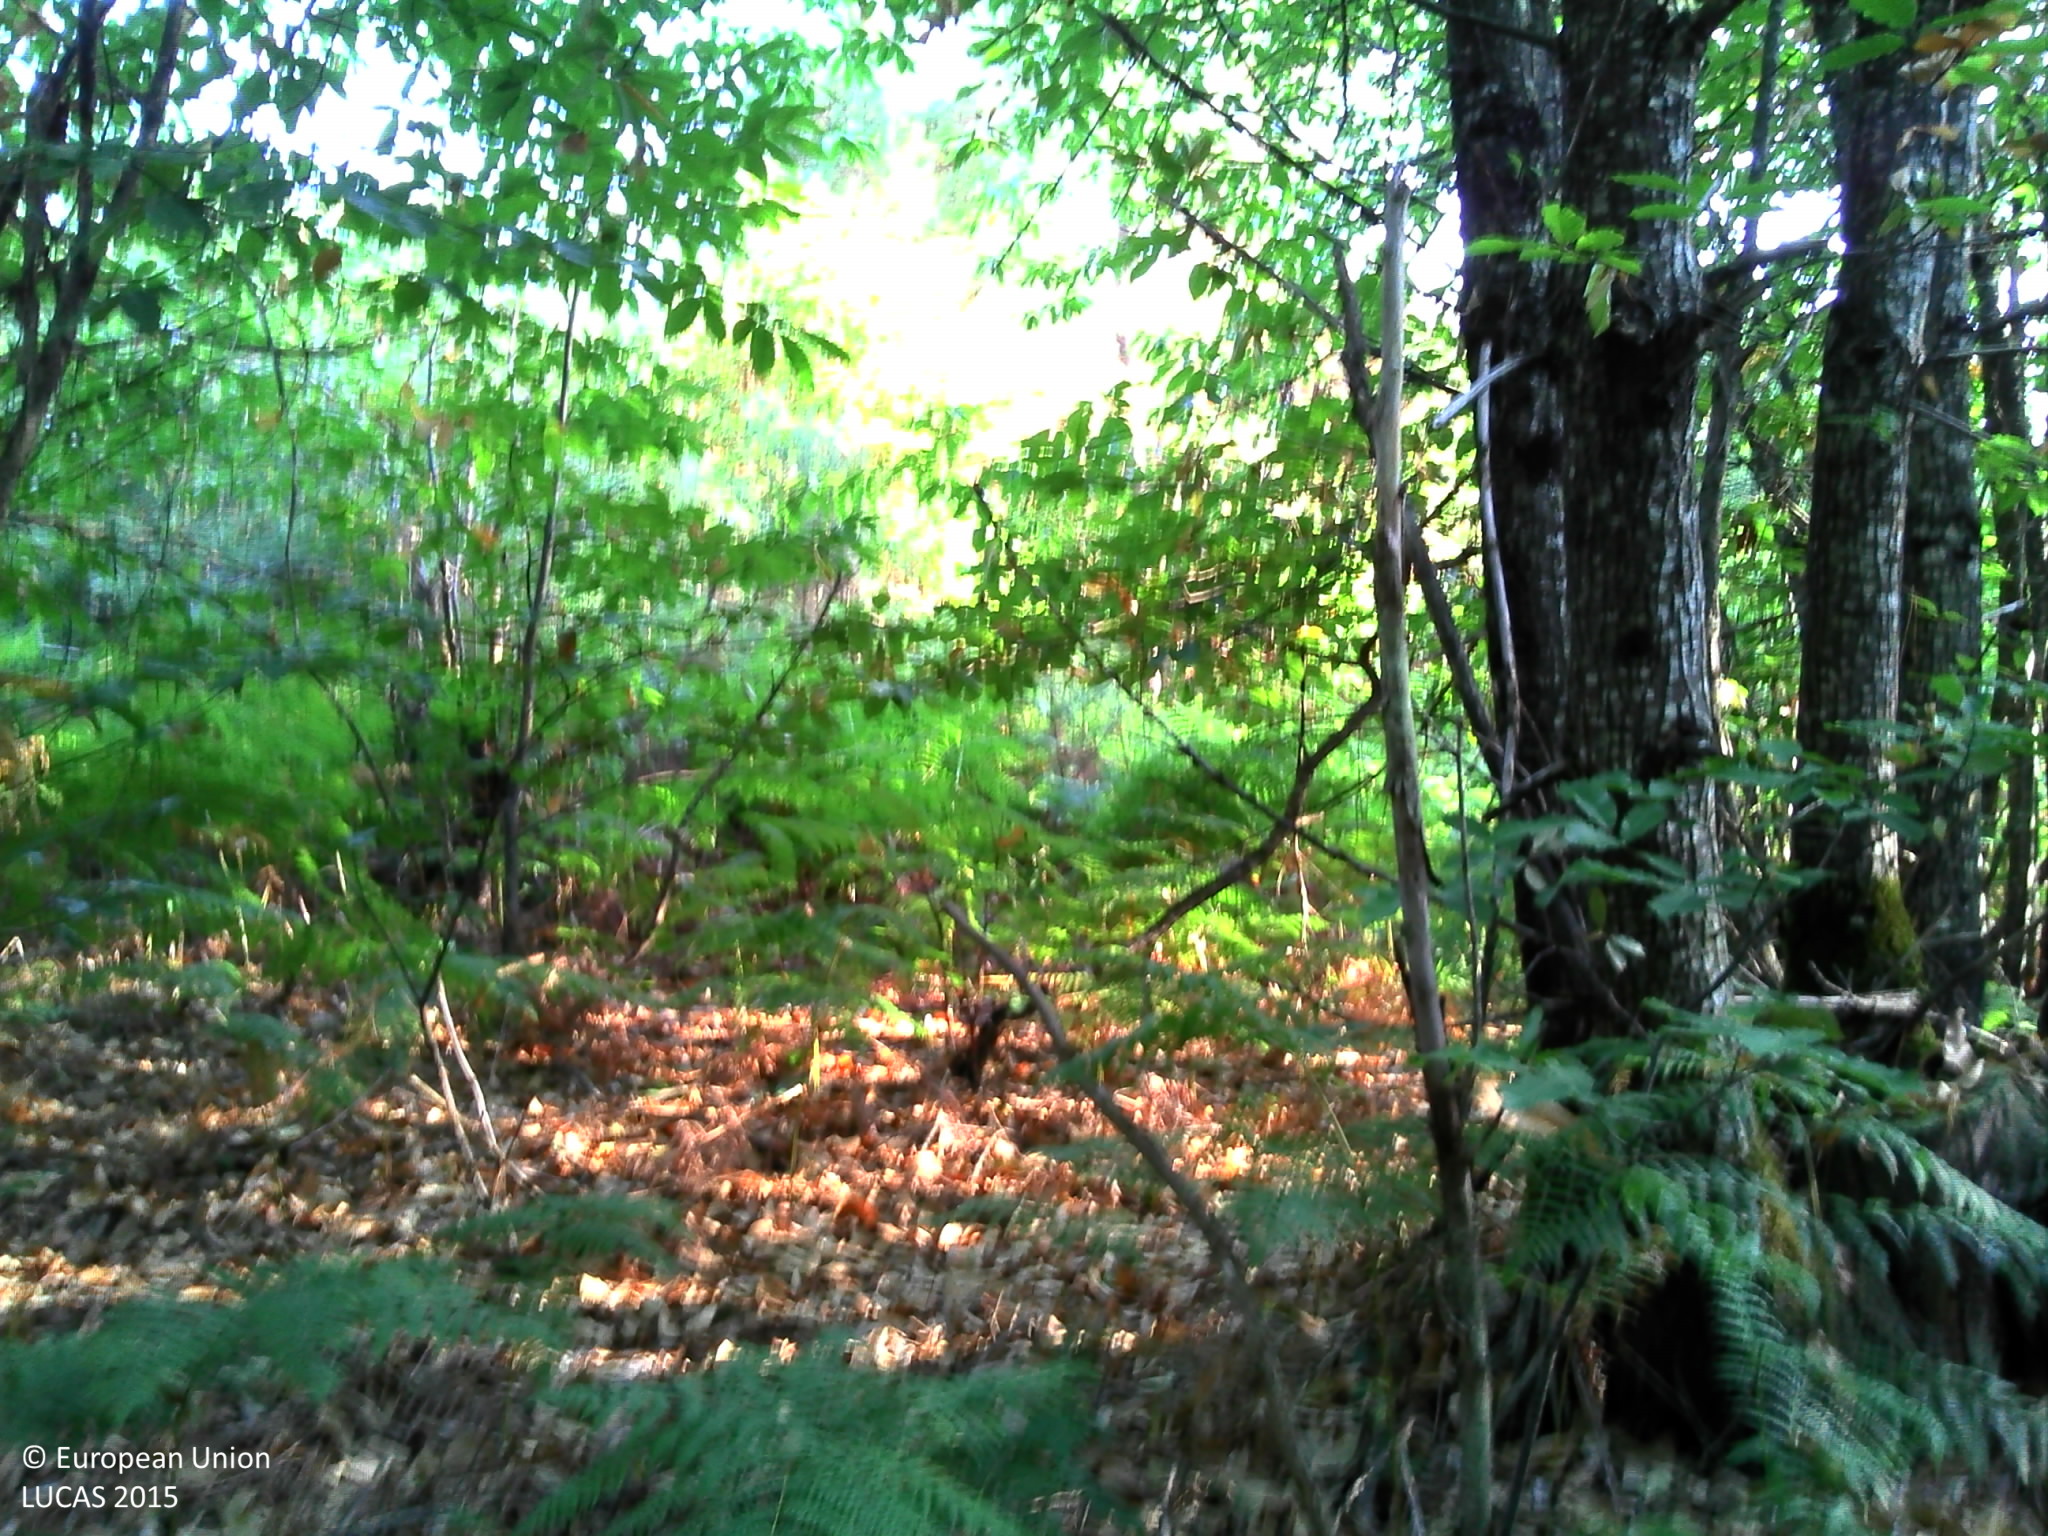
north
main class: Woodland
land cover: Broadleaved woodland
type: thermophilous deciduous forest
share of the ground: > 75 %
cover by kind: broadleaved forest trees 80 %, herbaceous plants 10 %, shrubs 5 %, lichens and mosses 5 %
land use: Forestry
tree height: > 5 m
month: August
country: FR
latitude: 44.7714
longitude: 0.9592
